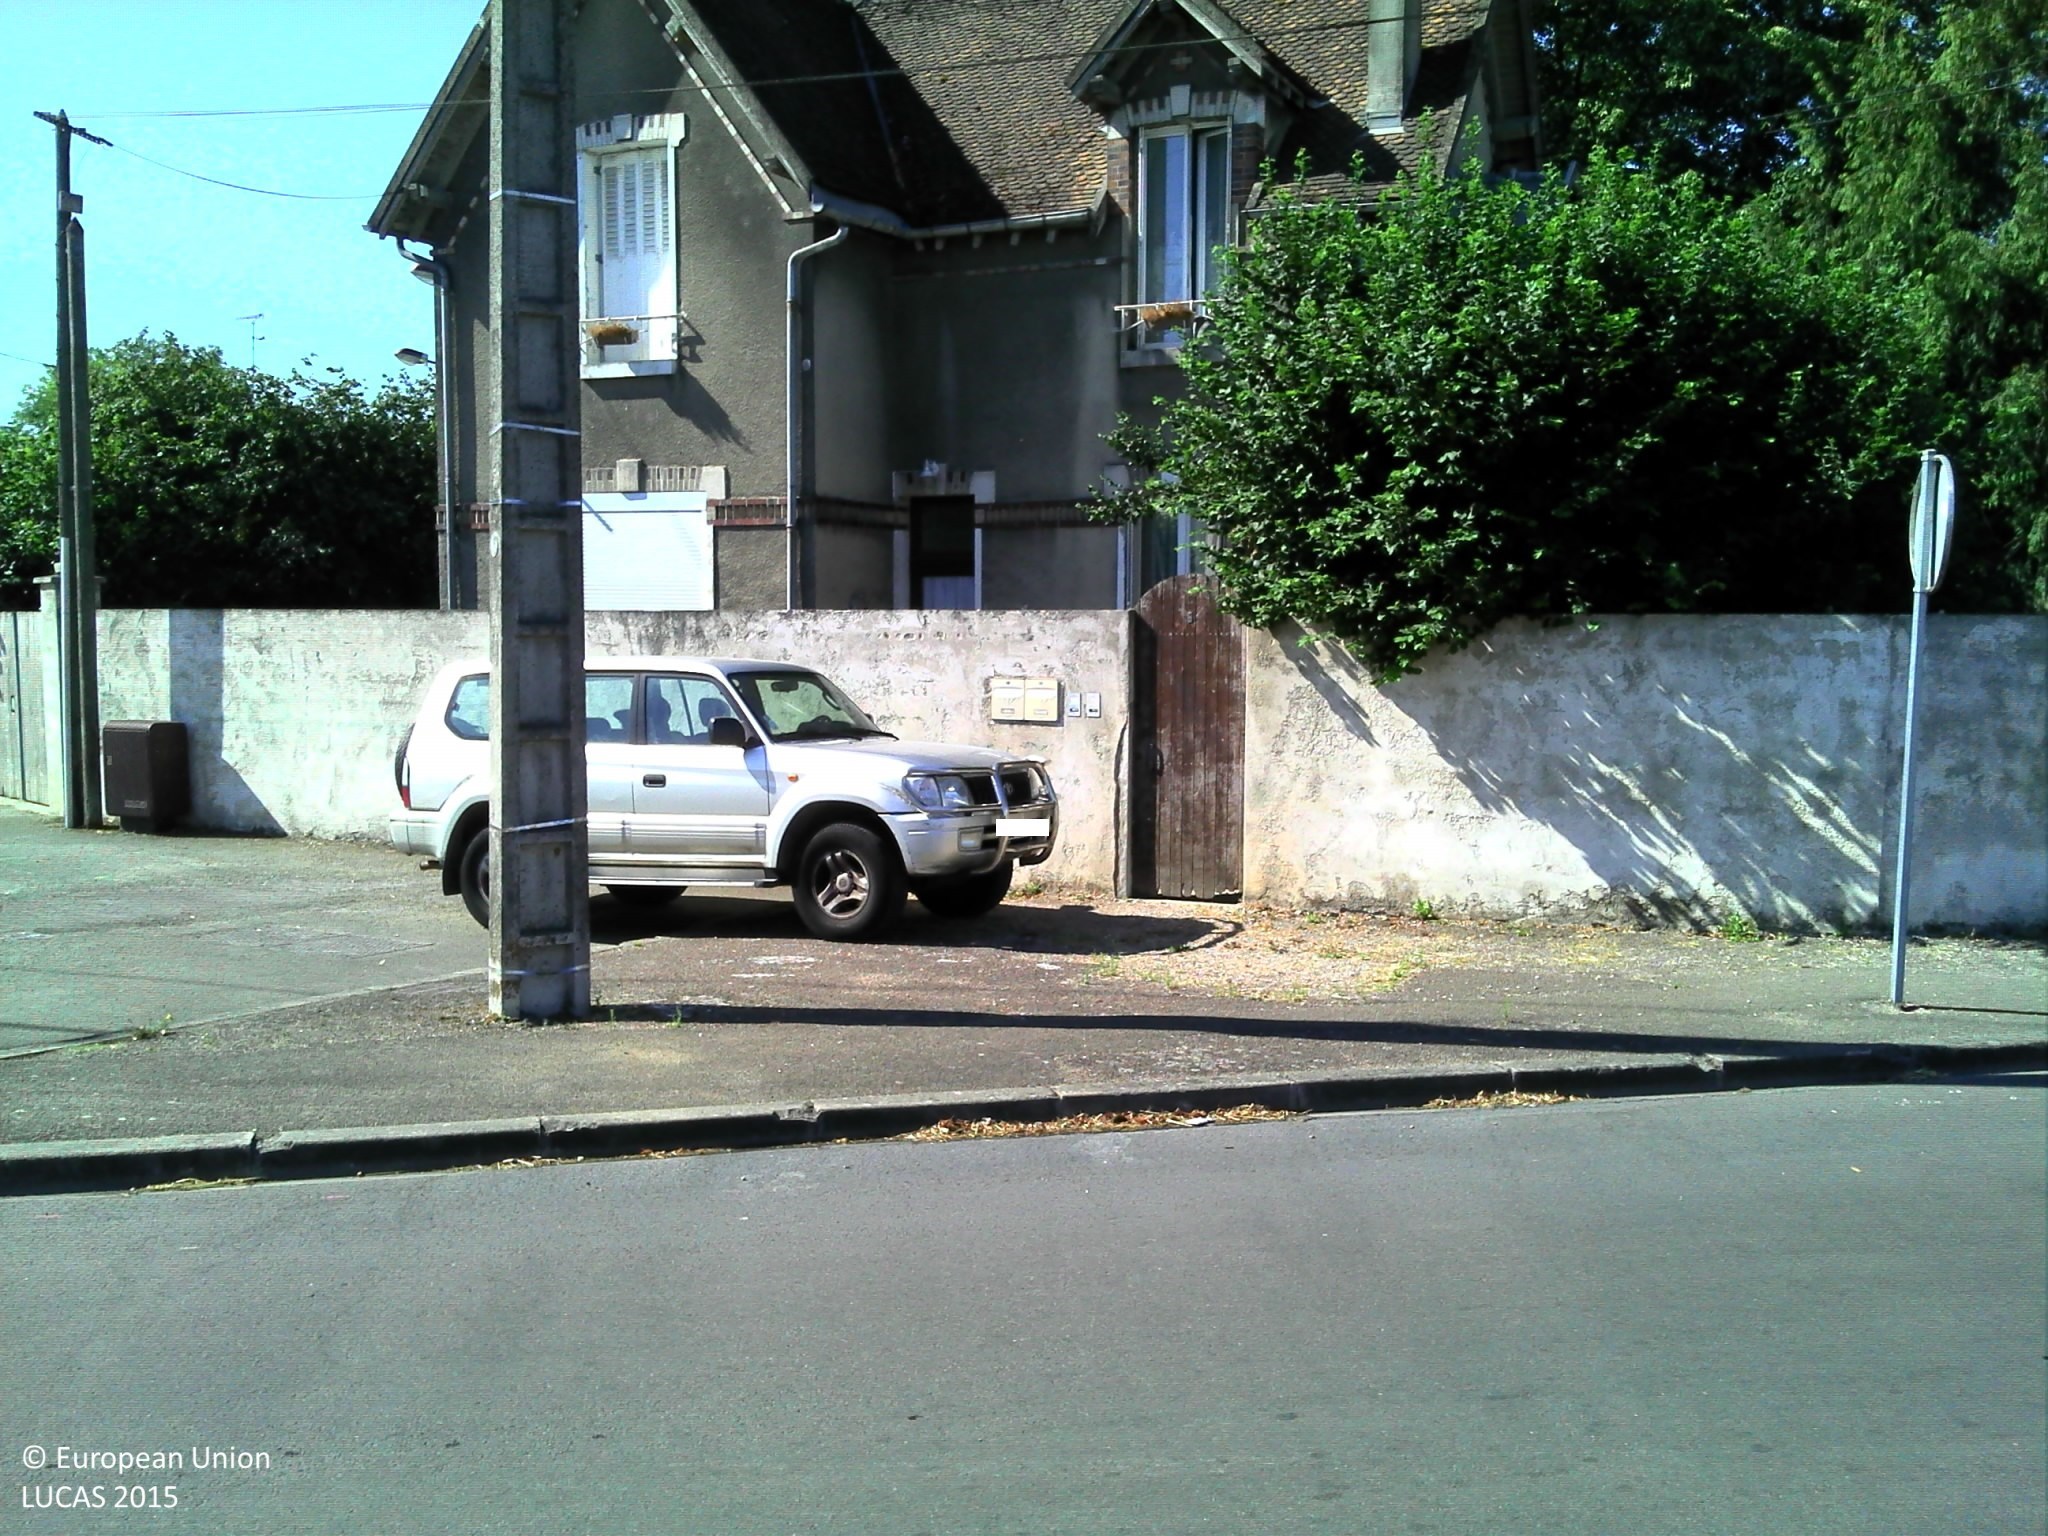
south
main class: Cropland
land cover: Floriculture and ornamental plants
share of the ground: > 75 %
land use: Community services
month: August
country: FR
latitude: 47.9610
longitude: 3.5266
